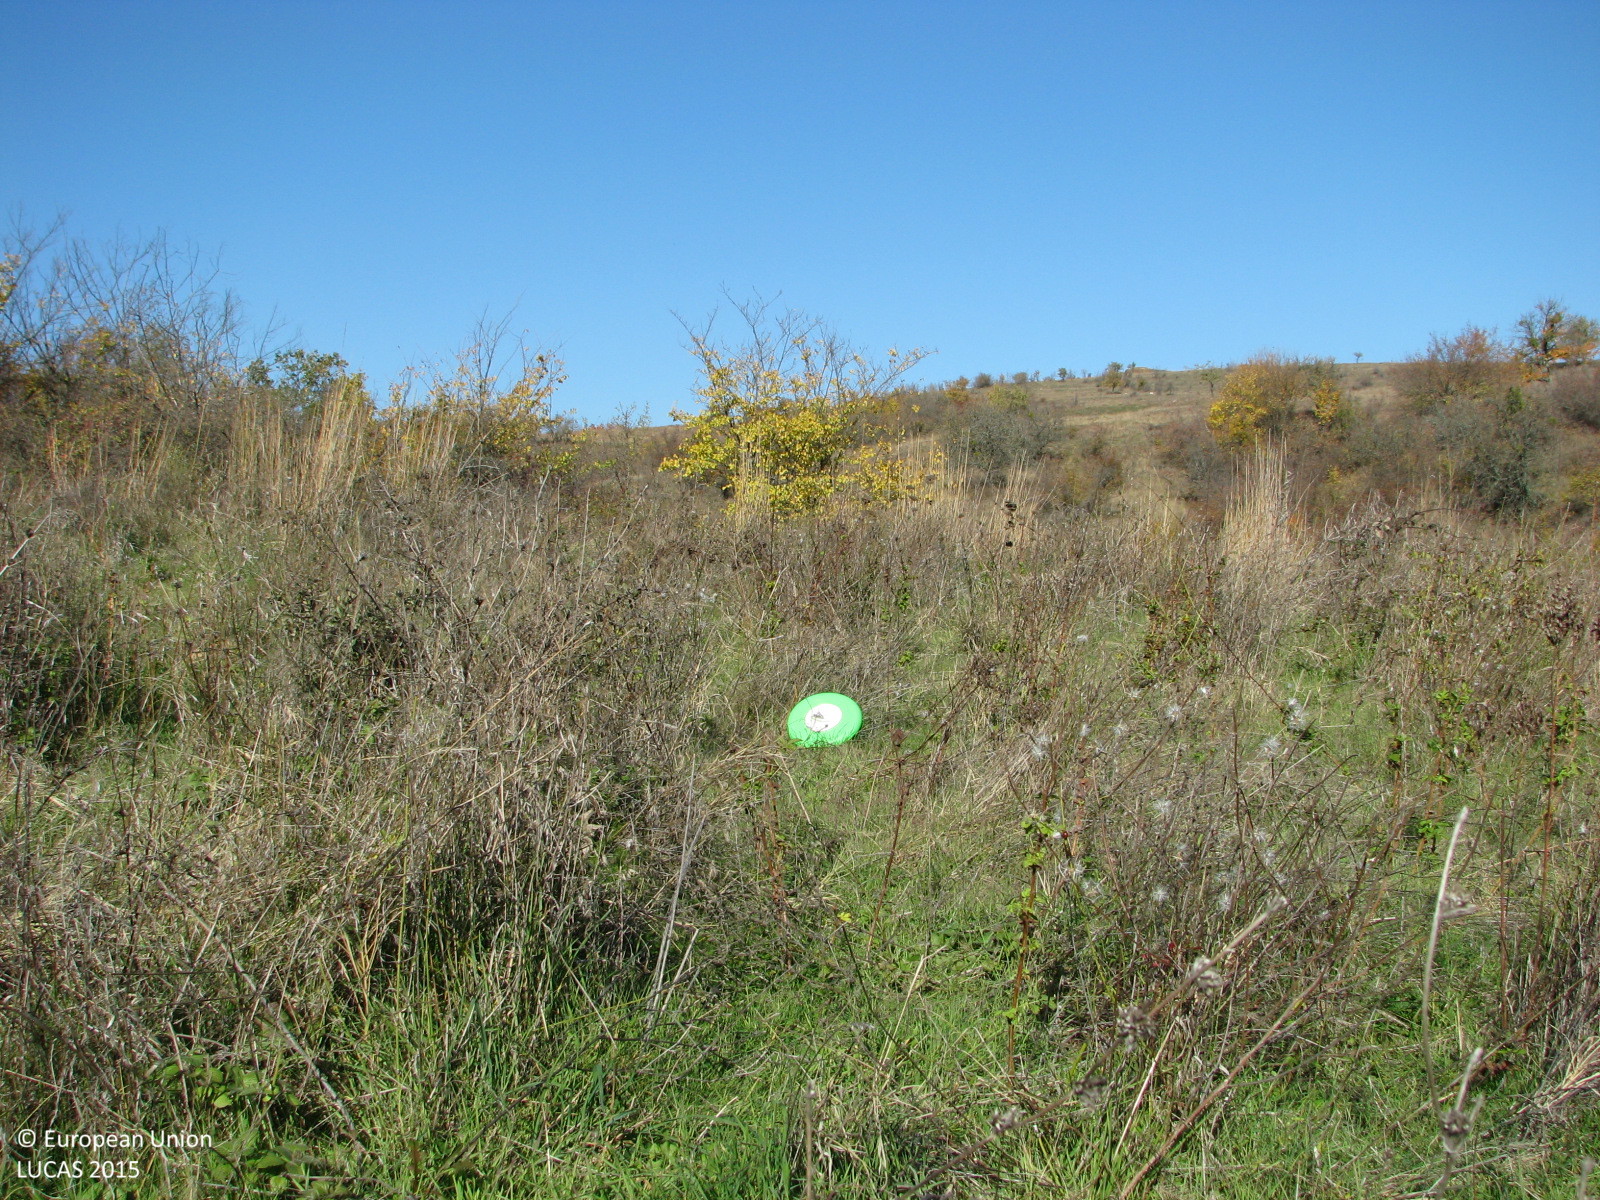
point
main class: Grassland
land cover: Grassland with sparse tree/shrub cover
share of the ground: > 75 %
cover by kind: herbaceous plants 90 %, broadleaved forest trees 5 %, shrubs 5 %
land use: Agriculture (excluding fallow land and kitchen gardens)
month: November
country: BG
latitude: 41.8968
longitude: 26.3899
